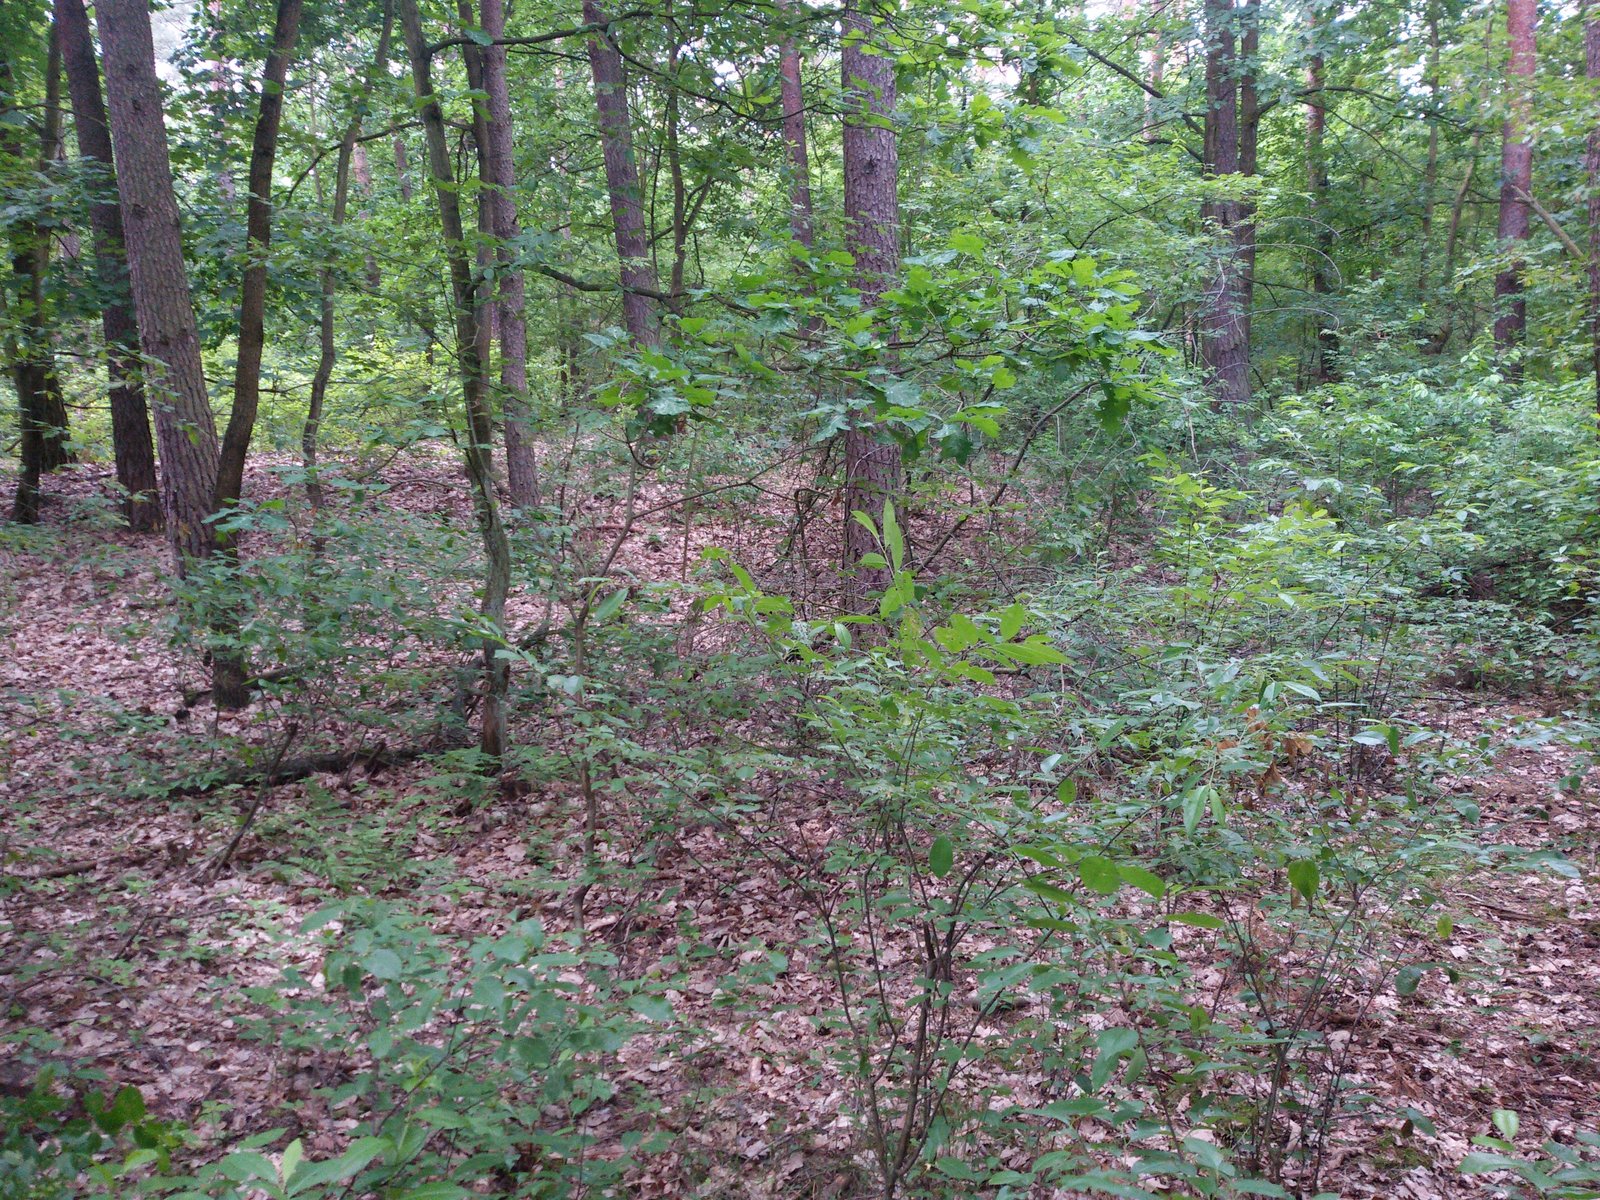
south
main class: Woodland
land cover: Other mixed woodland
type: hemiboreal forest and nemoral coniferous forest and mixed broadleaved-coniferous forest
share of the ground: > 75 %
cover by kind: broadleaved forest trees 50 %, coniferous forest trees 45 %, lichens and mosses 5 %
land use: Forestry
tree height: > 5 m
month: June
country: PL
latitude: 52.4774
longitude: 17.0033
